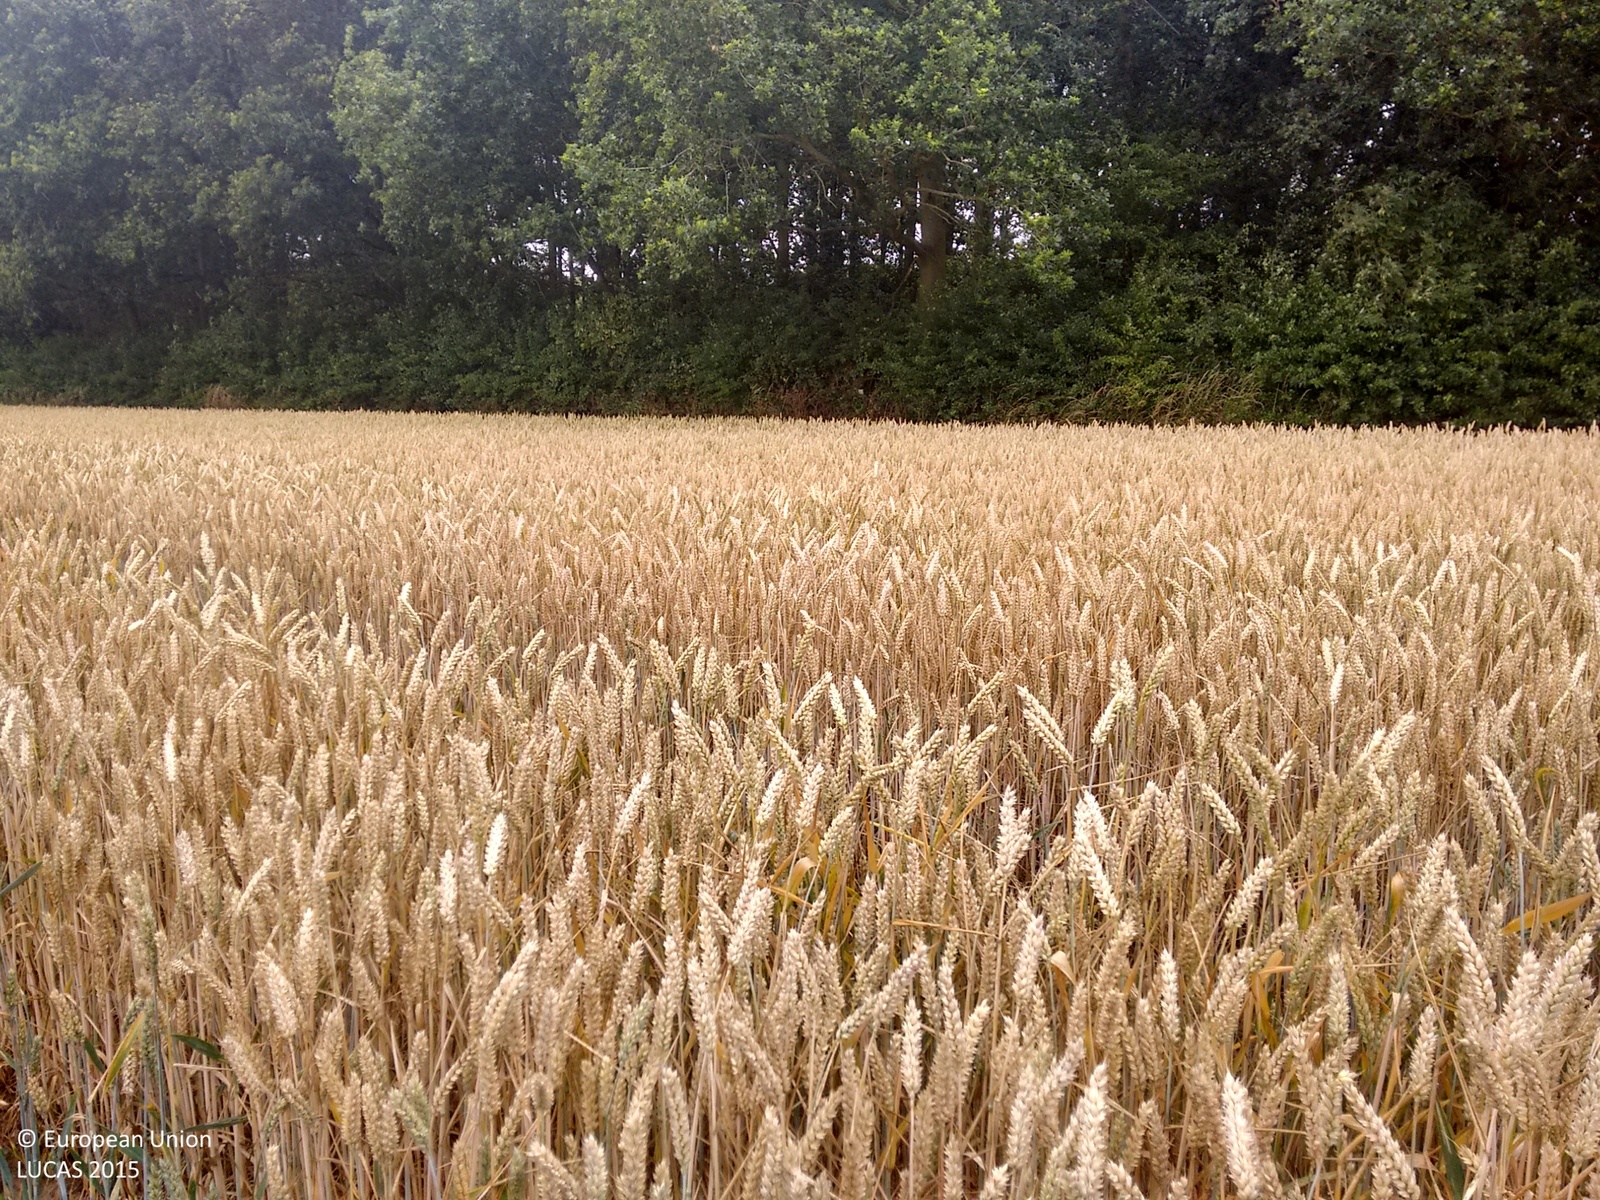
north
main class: Cropland
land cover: Common wheat
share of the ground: > 75 %
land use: Agriculture (excluding fallow land and kitchen gardens)
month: July
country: GB
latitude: 52.6491
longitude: -2.2565
